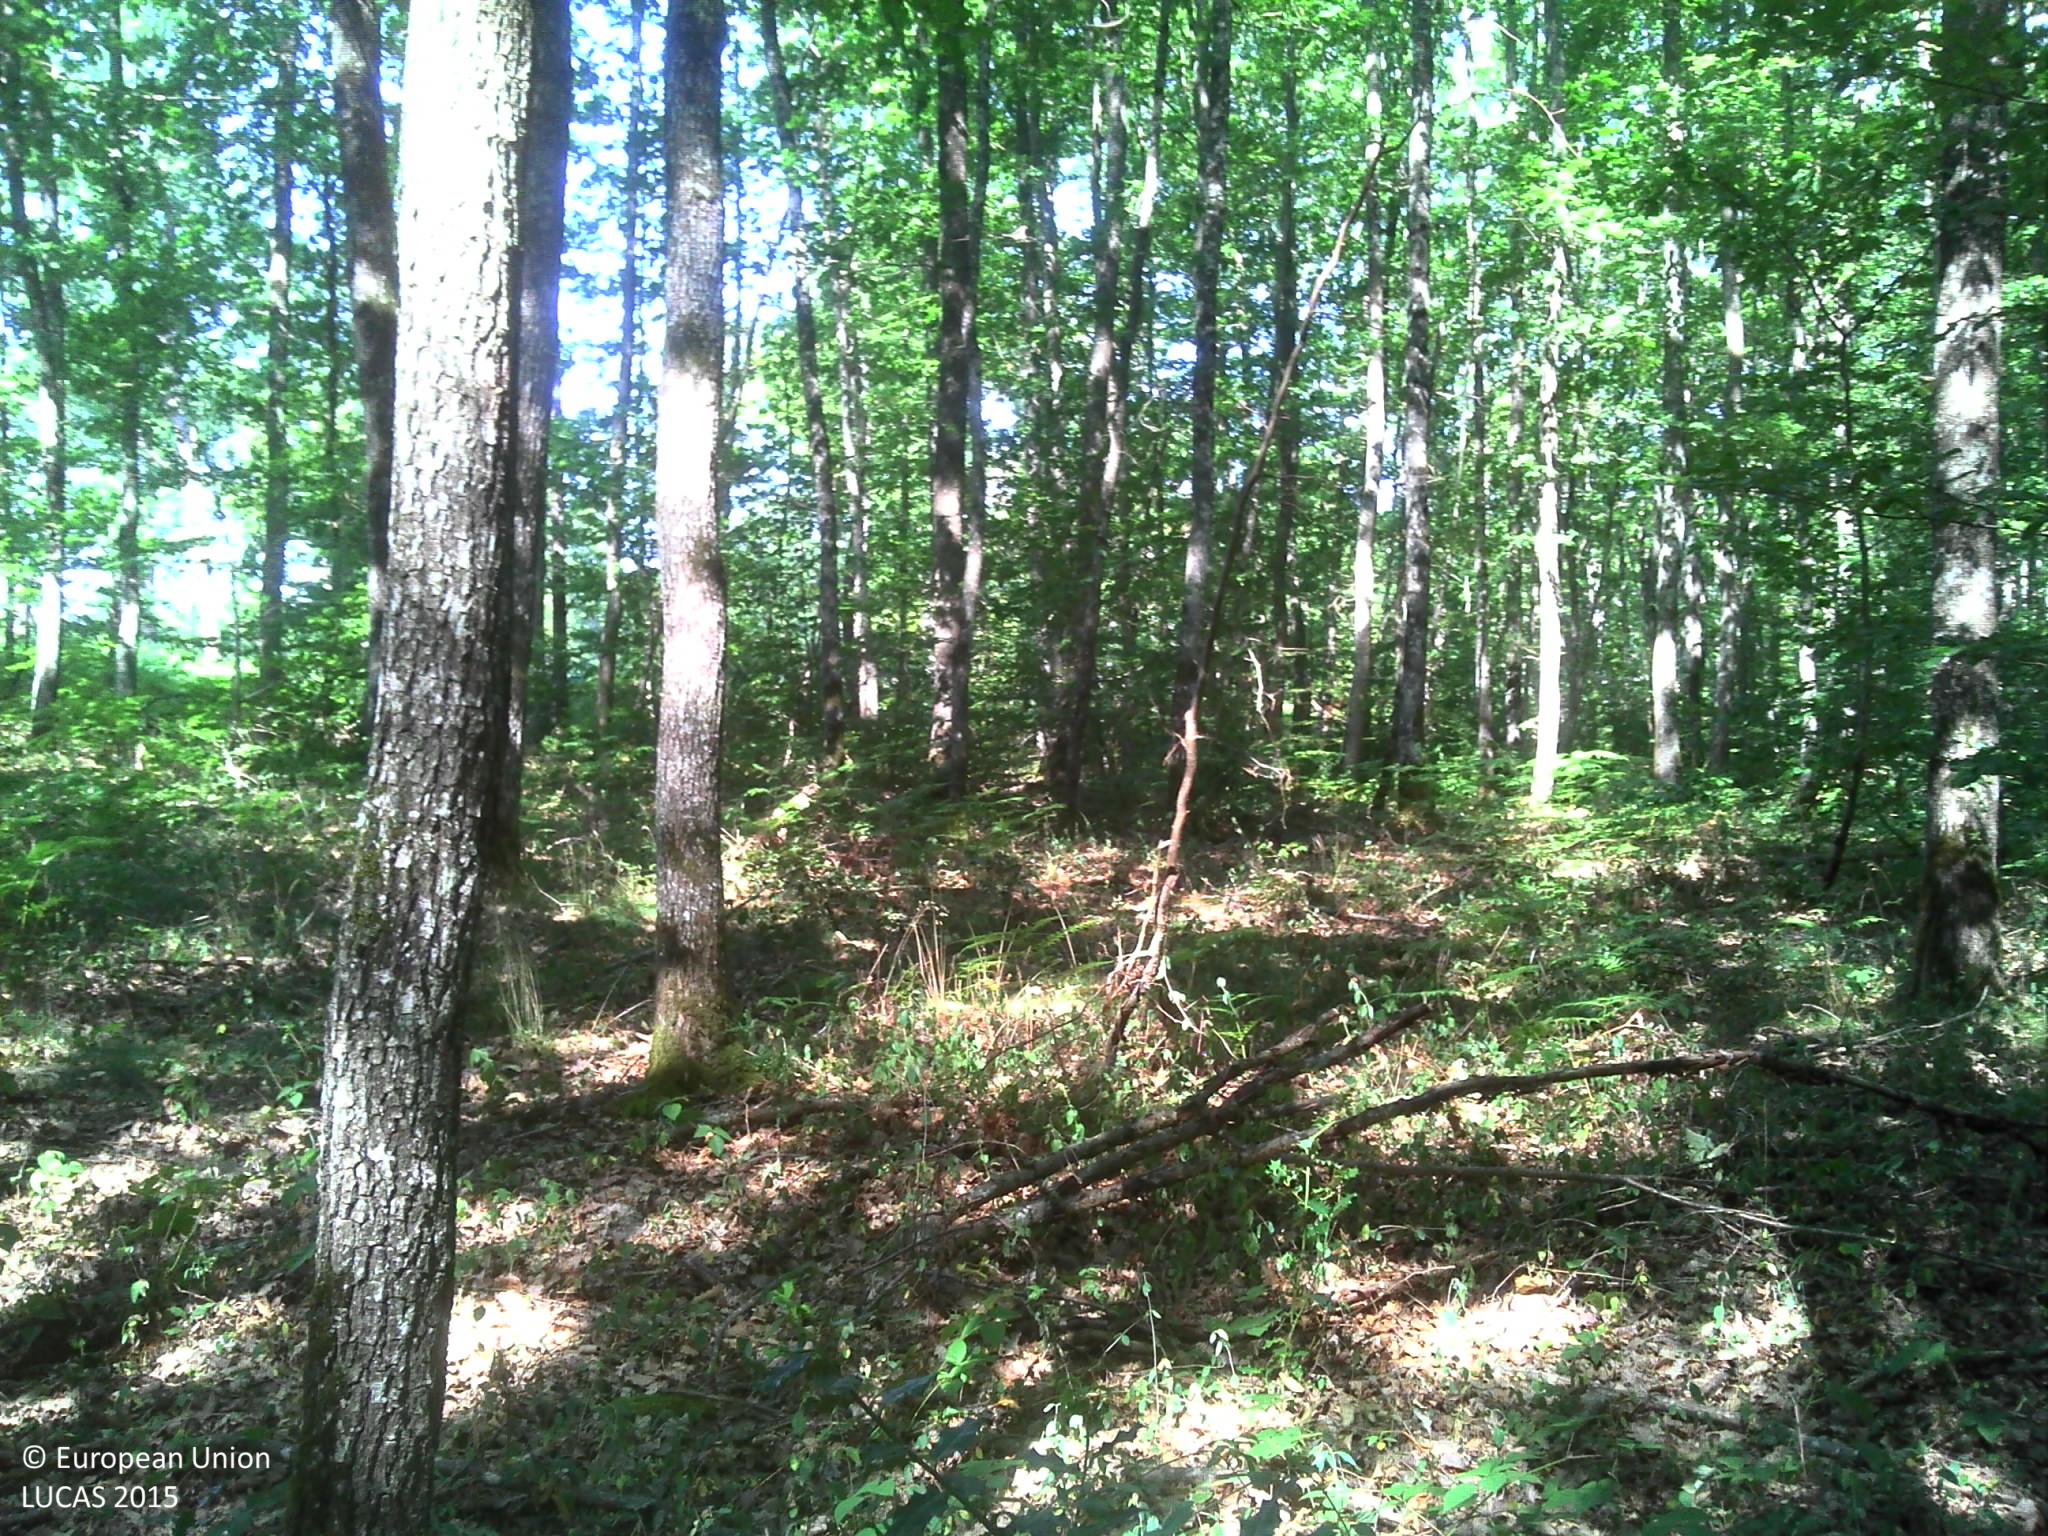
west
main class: Woodland
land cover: Broadleaved woodland
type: mesophytic deciduous forest
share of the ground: > 75 %
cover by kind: broadleaved forest trees 95 %, herbaceous plants 5 %
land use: Forestry
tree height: > 5 m
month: July
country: FR
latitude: 46.4303
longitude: 2.7477
